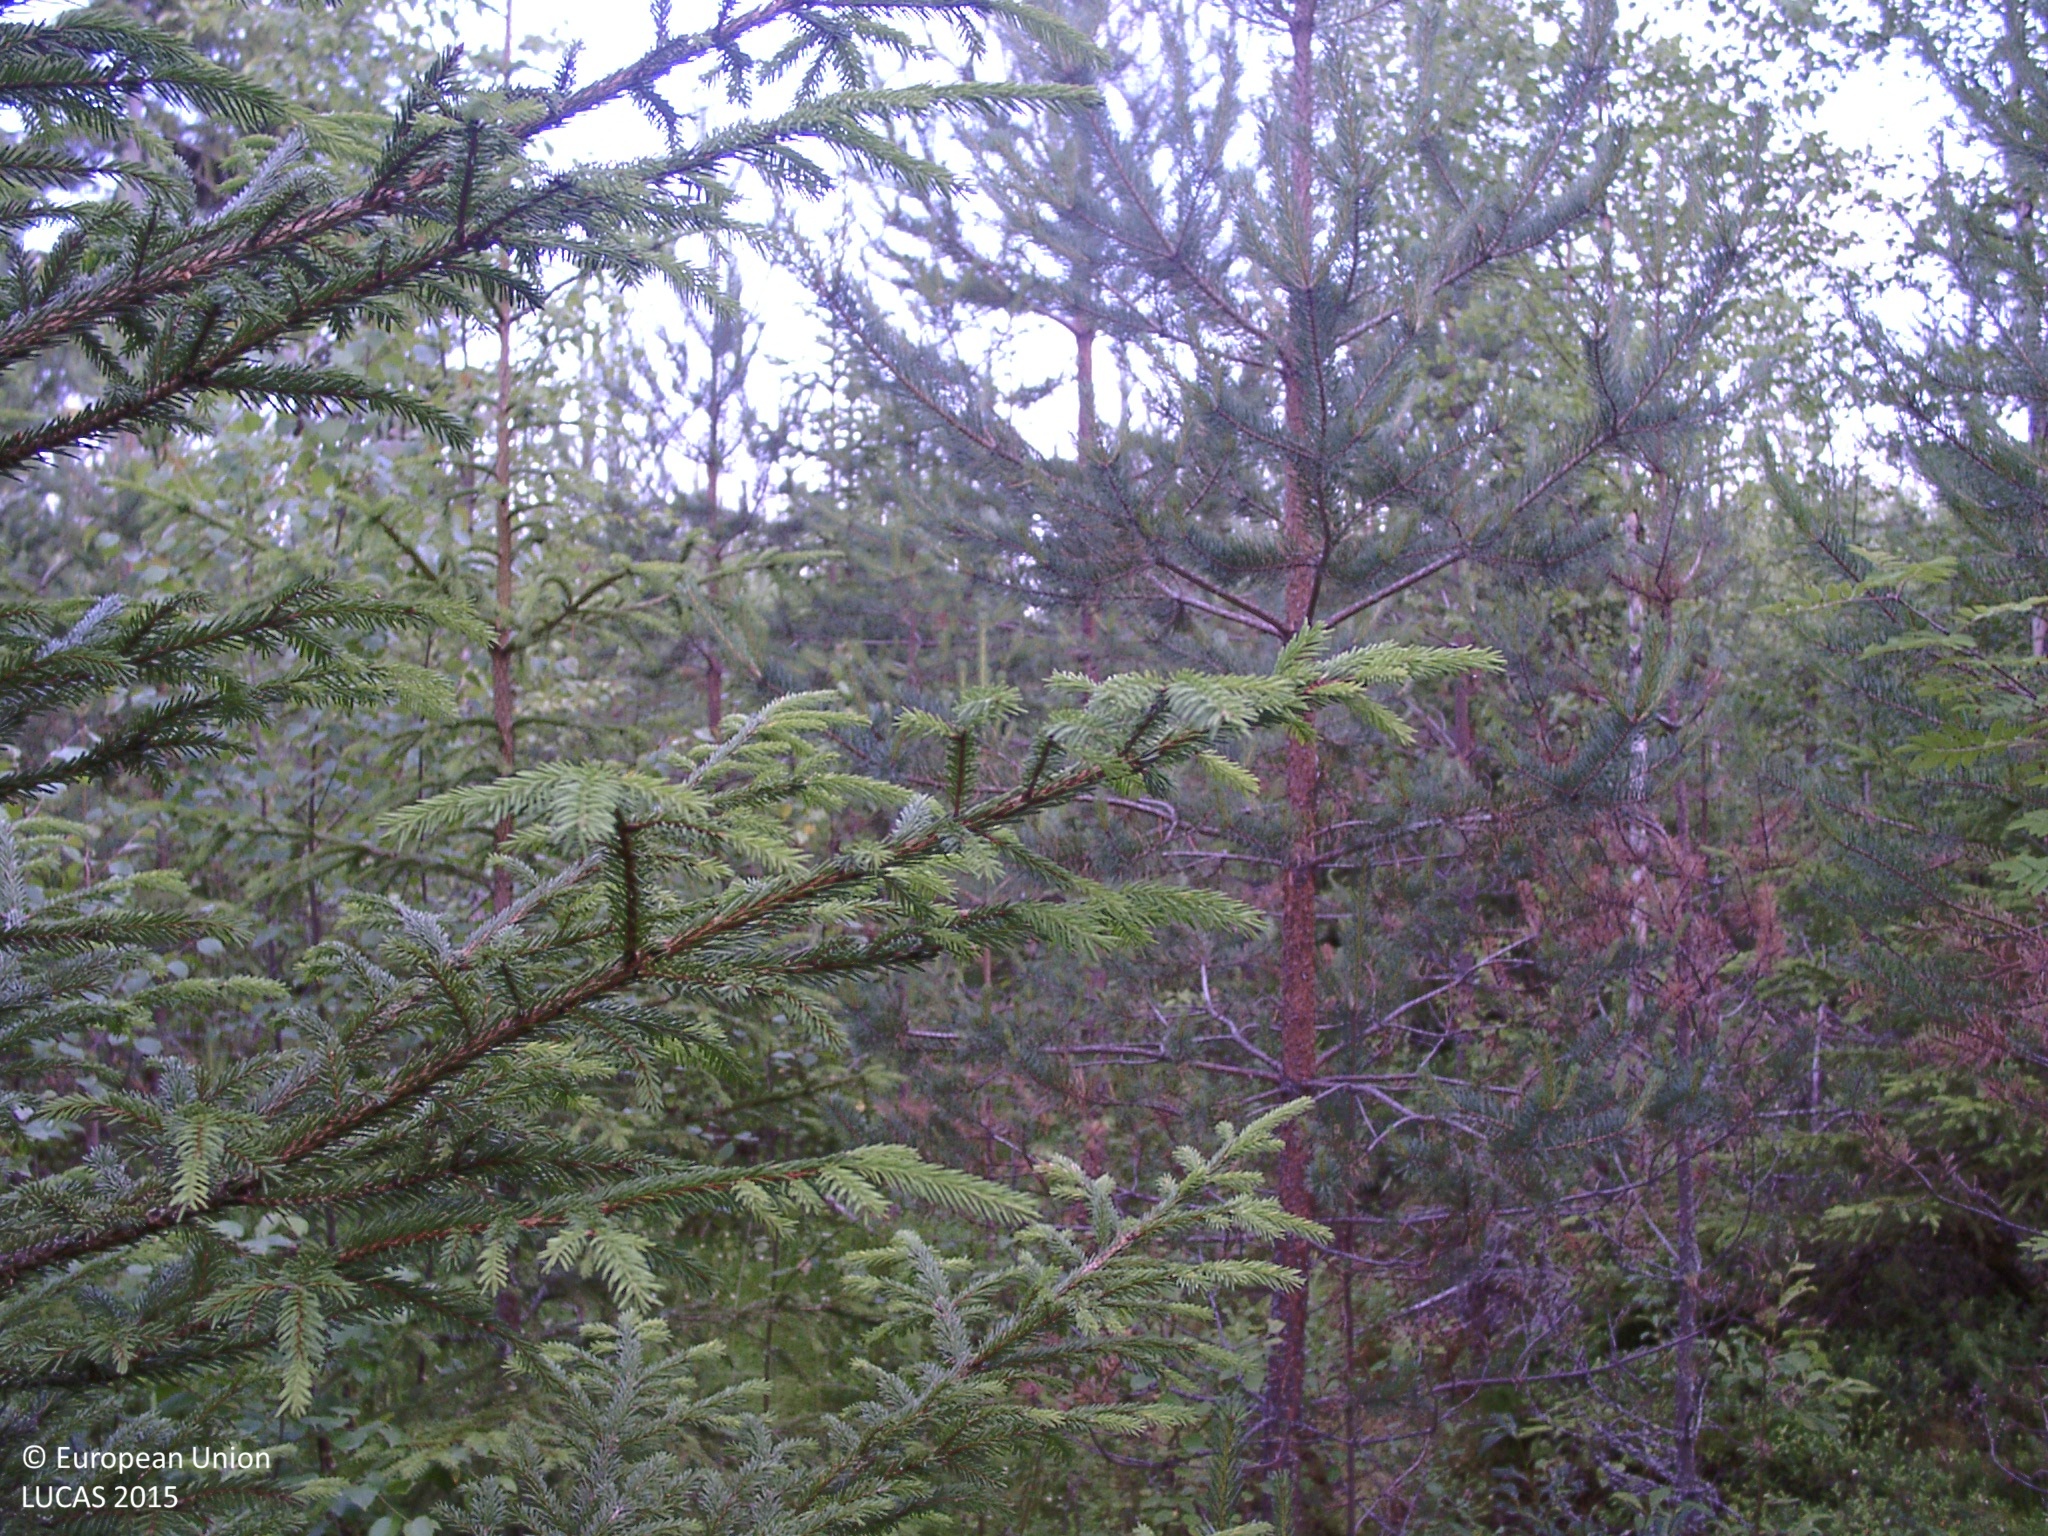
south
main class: Woodland
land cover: Other mixed woodland
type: boreal forest
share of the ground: 50 - 75 %
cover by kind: coniferous forest trees 50 %, broadleaved forest trees 20 %, shrubs 15 %, herbaceous plants 5 %, lichens and mosses 5 %
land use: Forestry
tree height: < 5 m
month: July
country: FI
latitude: 61.8399
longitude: 24.7842
